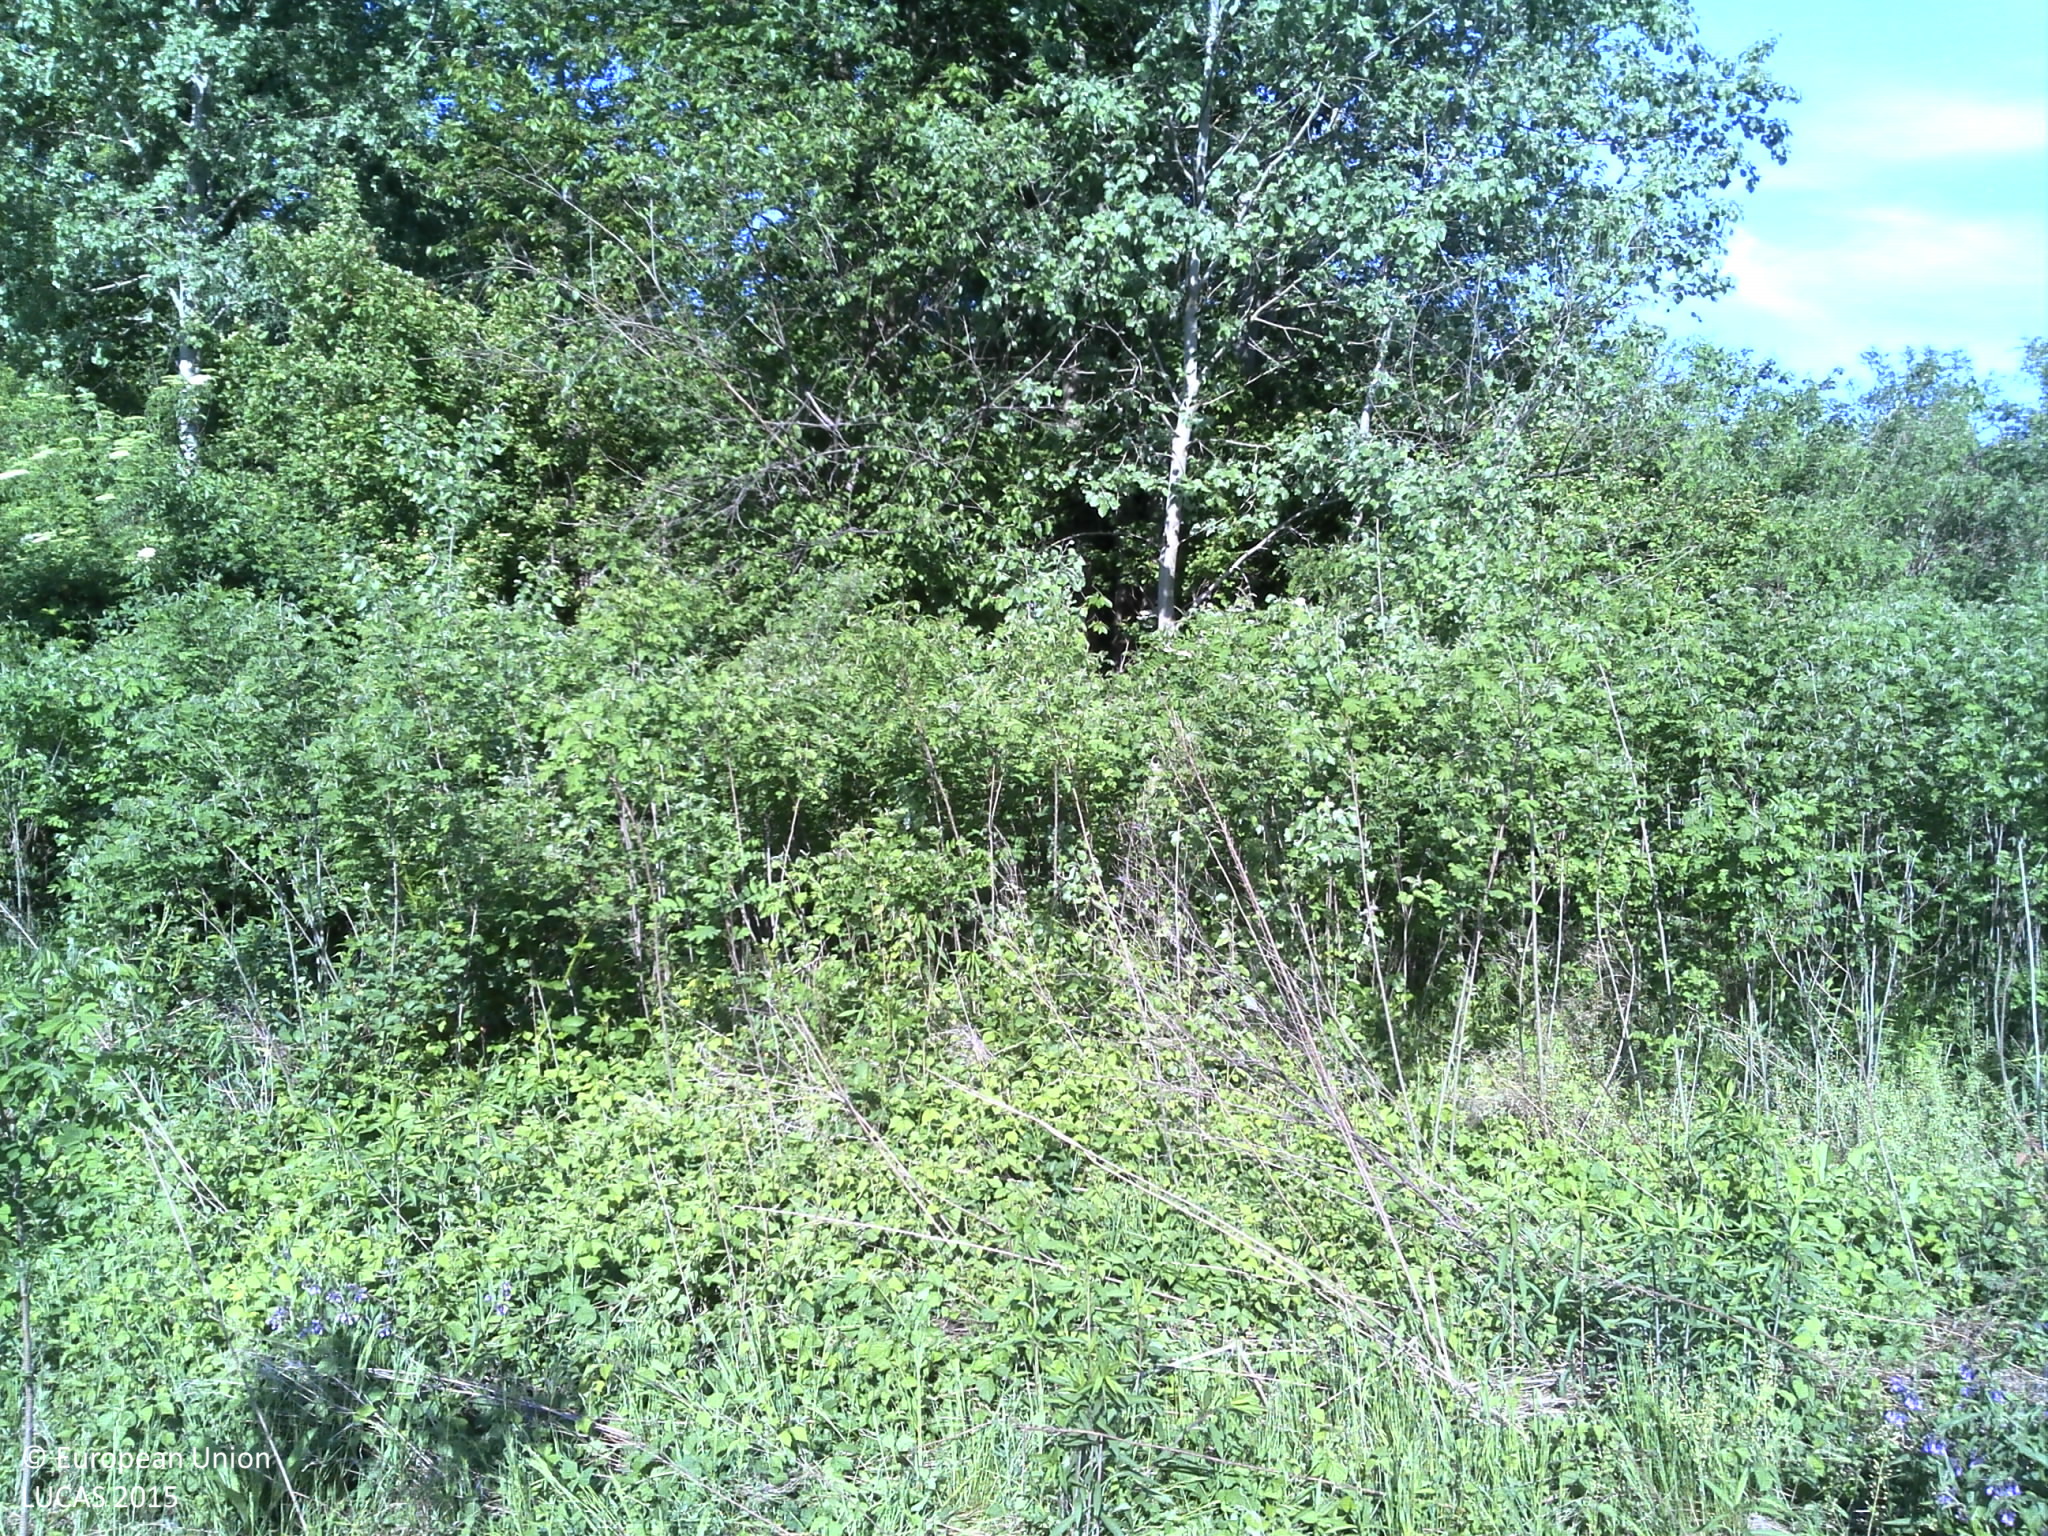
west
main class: Shrubland
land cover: Shrubland with sparse tree cover
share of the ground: > 75 %
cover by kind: shrubs 90 %, broadleaved forest trees 5 %, herbaceous plants 5 %
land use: Semi-natural and natural areas not in use
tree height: > 5 m
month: May
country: HR
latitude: 45.1302
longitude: 18.4342
